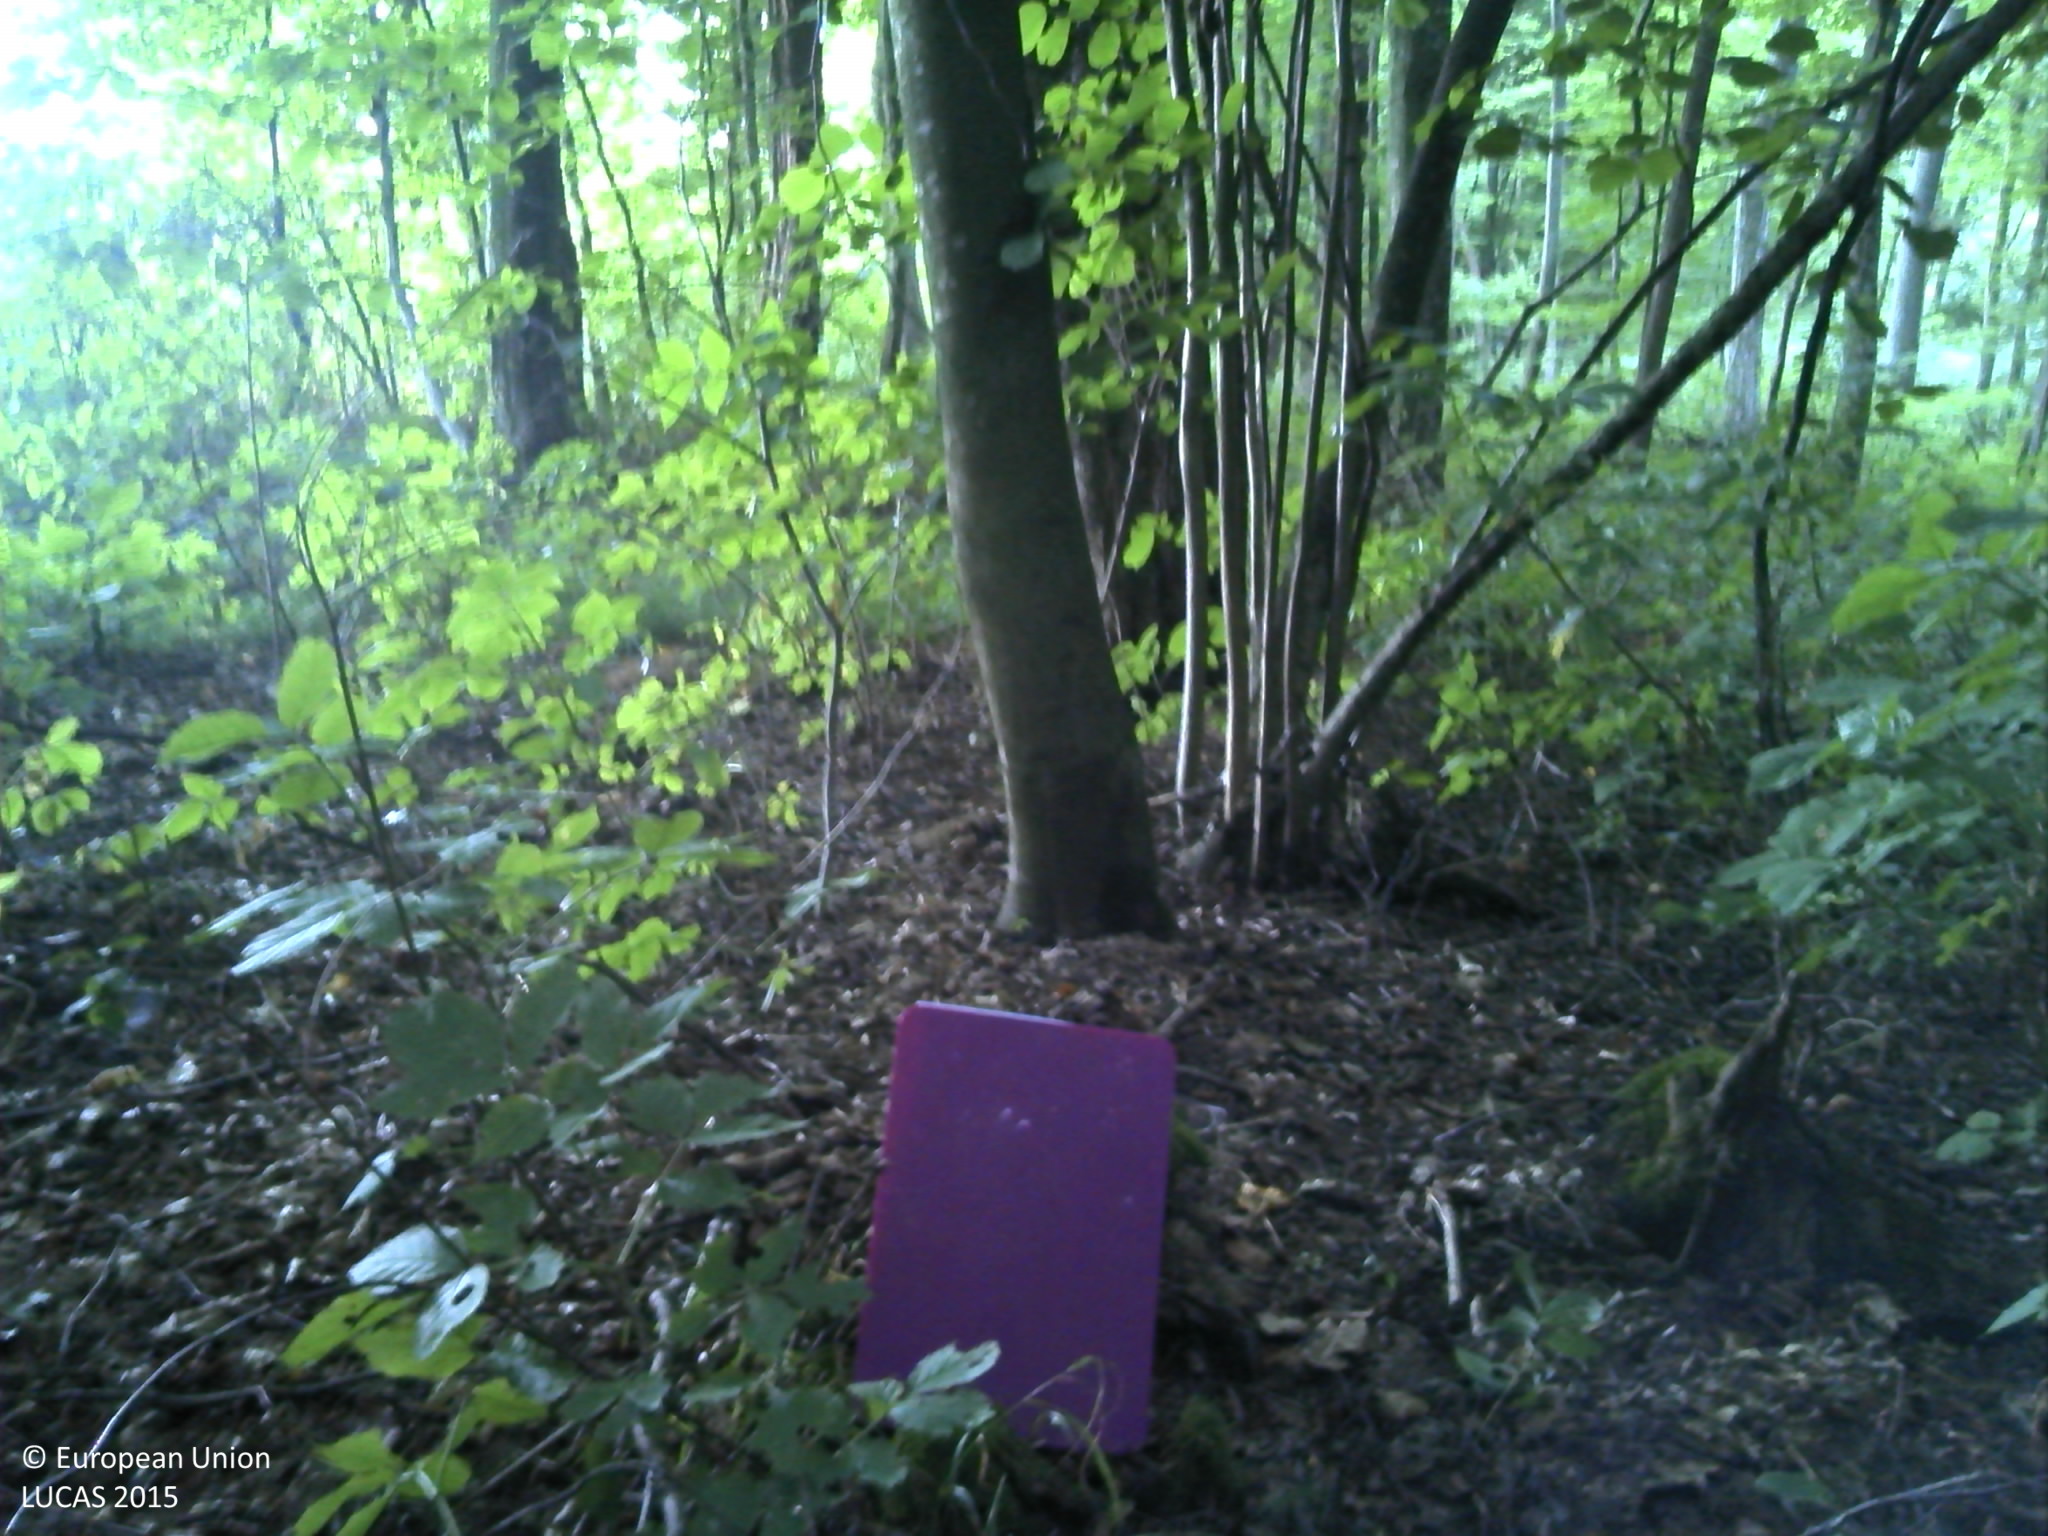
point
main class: Woodland
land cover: Broadleaved woodland
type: beech forest
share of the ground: > 75 %
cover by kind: broadleaved forest trees 100 %
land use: Forestry
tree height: > 5 m
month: August
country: HR
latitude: 45.5453
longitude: 17.2371
